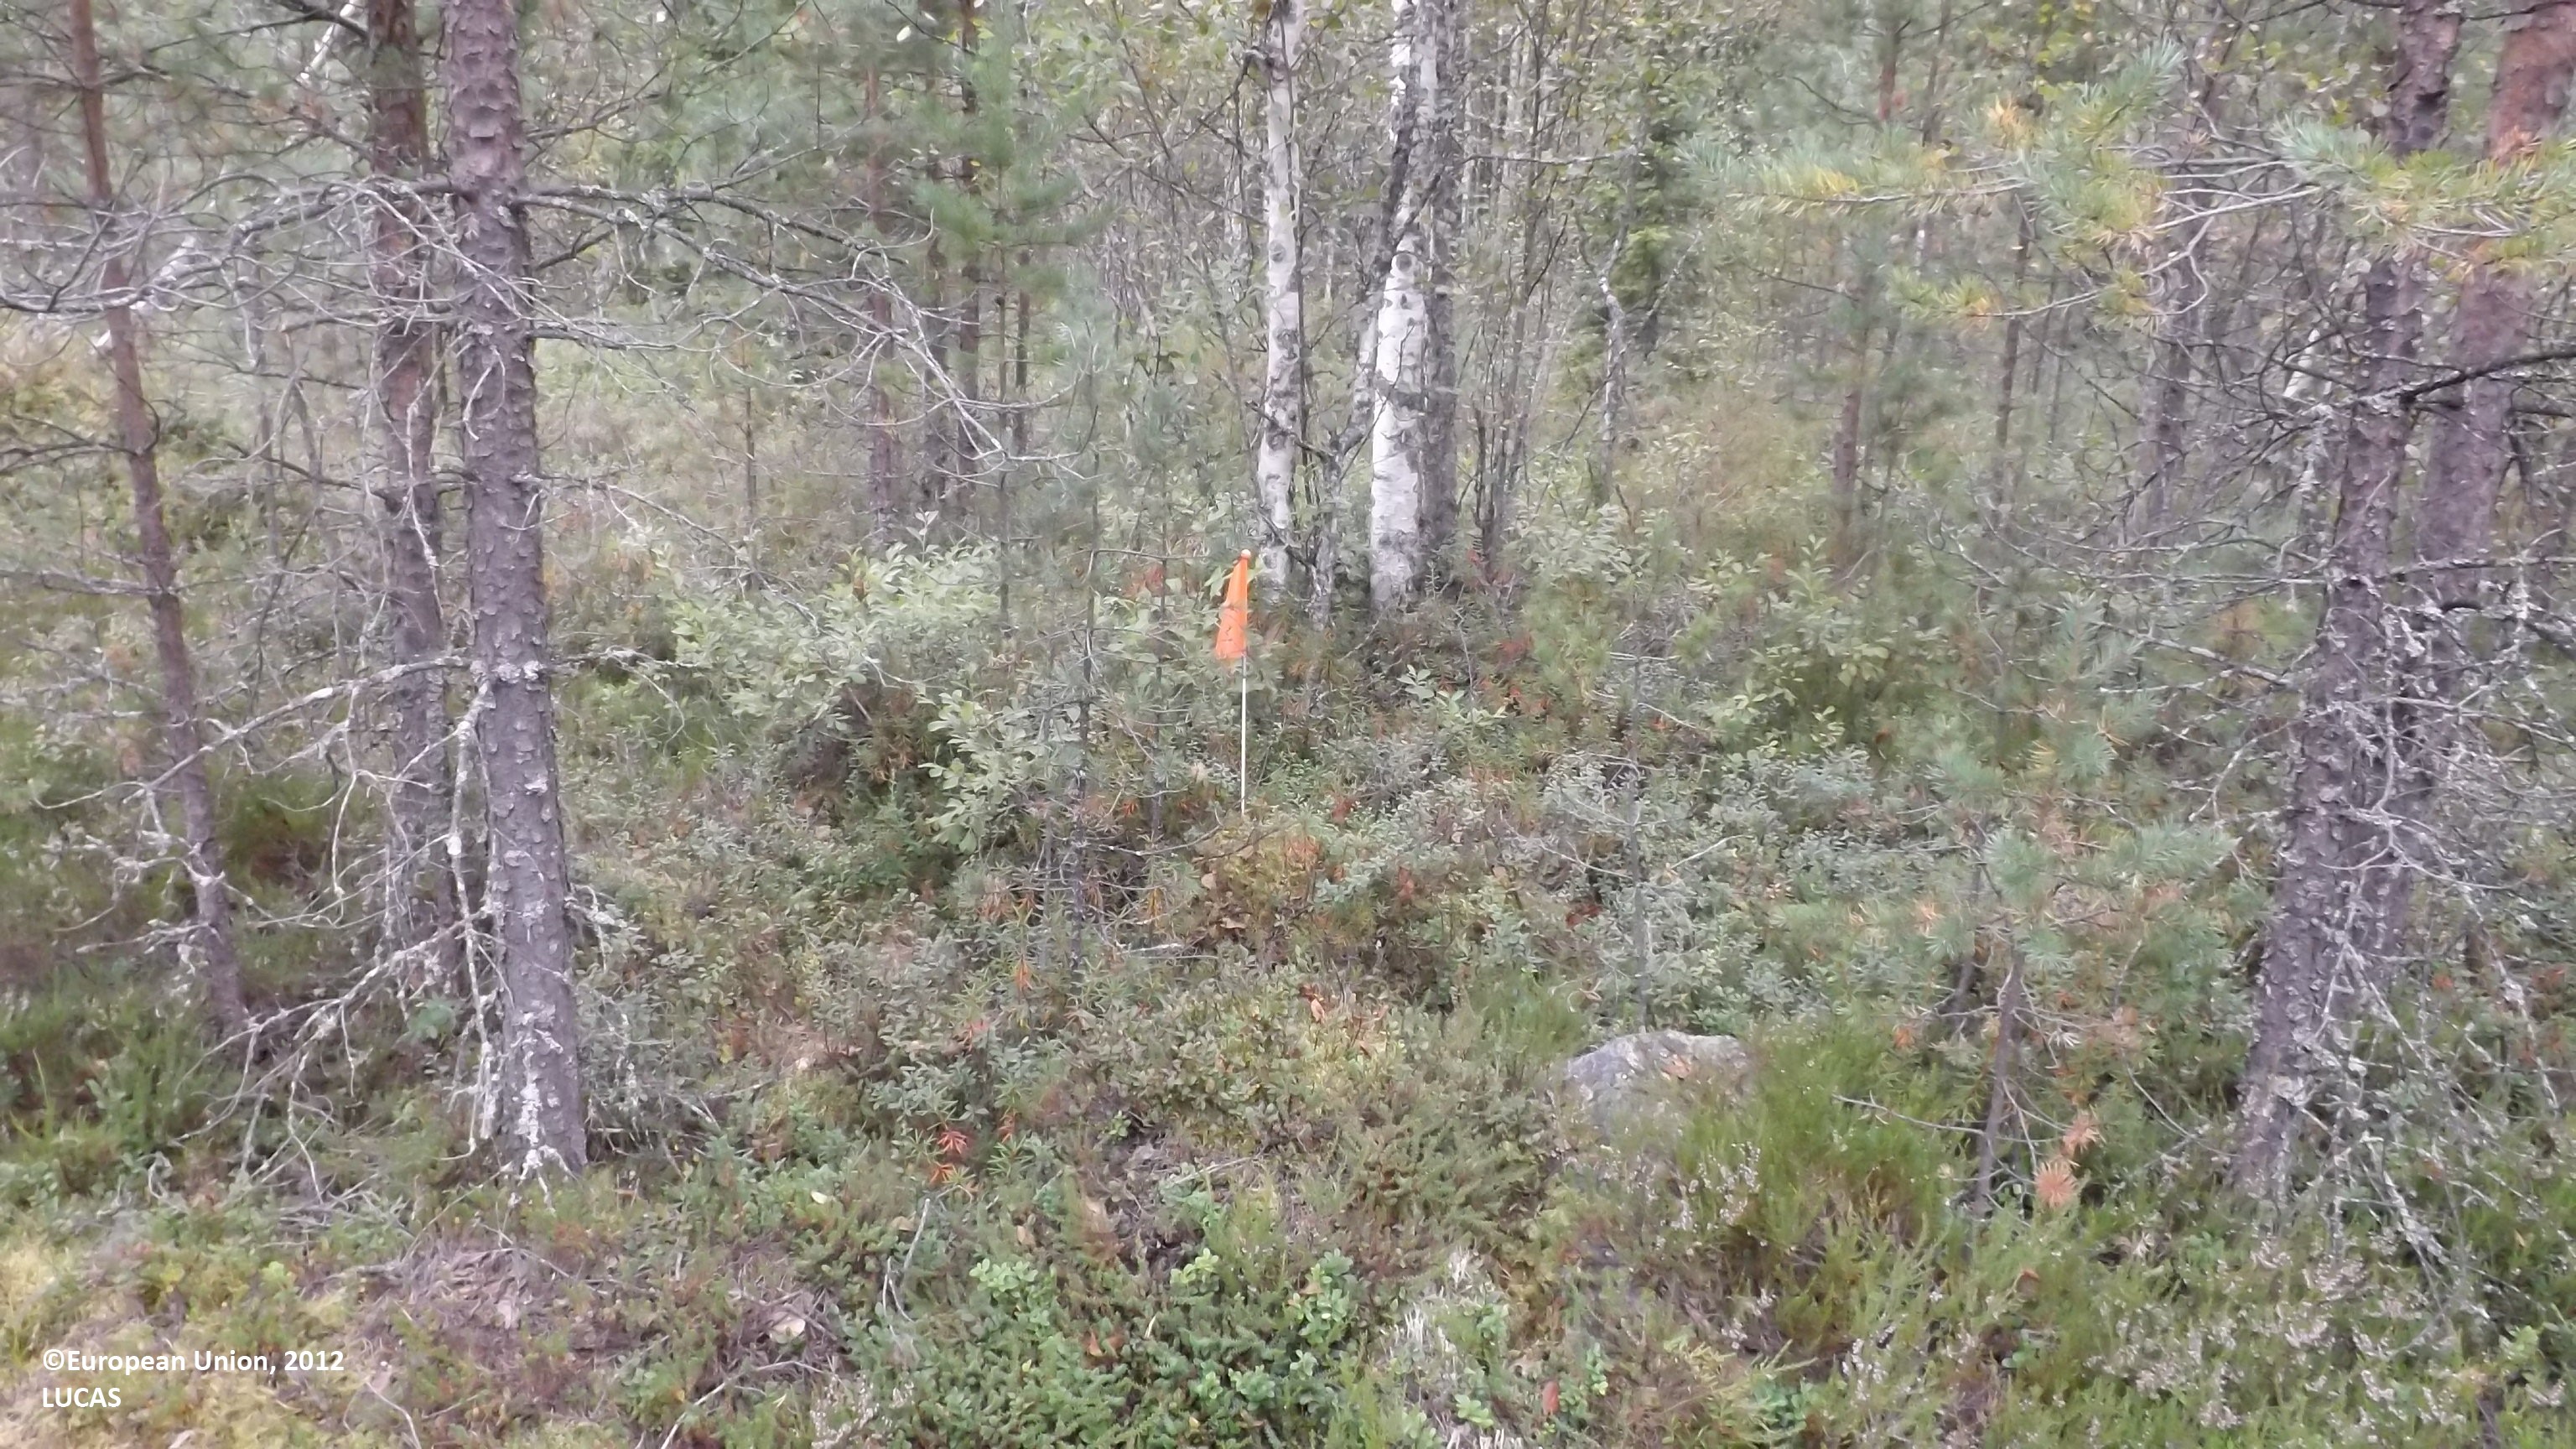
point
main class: Woodland
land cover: Pine dominated mixed woodland
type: boreal forest
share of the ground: 50 - 75 %
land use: Forestry
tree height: > 5 m
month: August
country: FI
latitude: 63.7734
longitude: 24.0014
